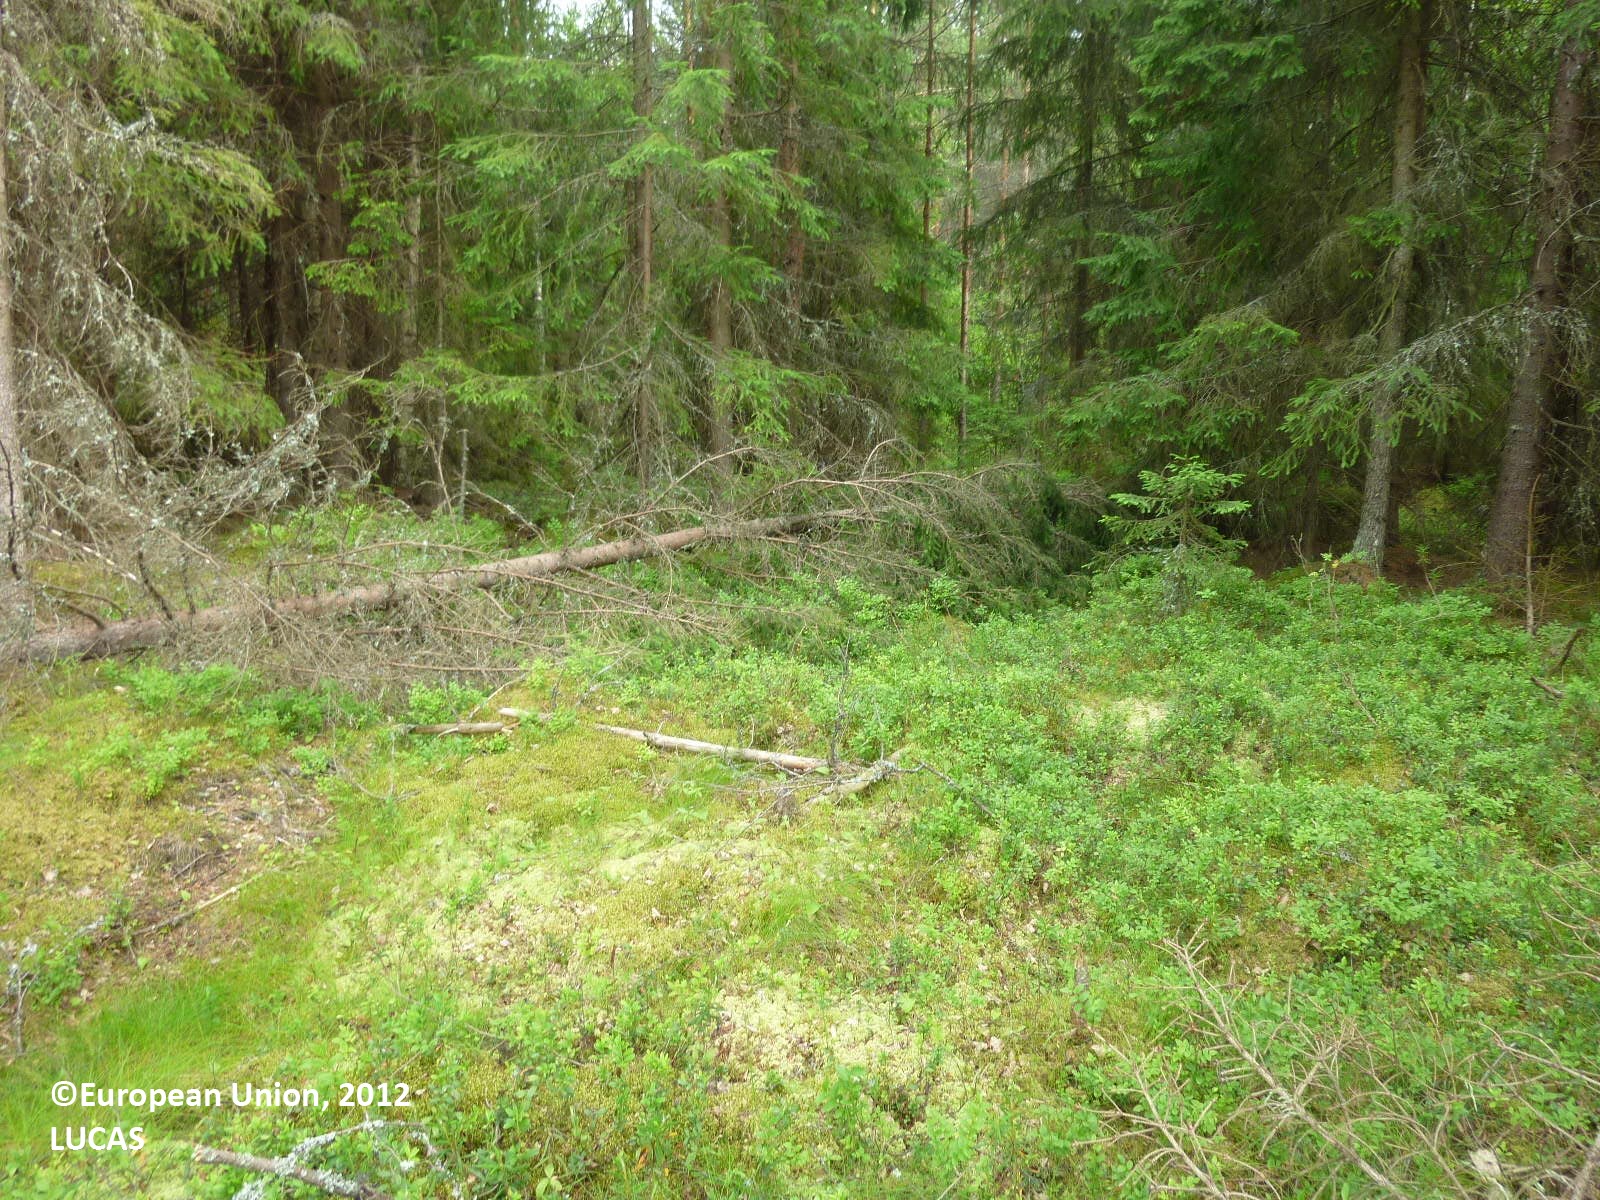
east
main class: Woodland
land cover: Spruce dominated mixed woodland
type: boreal forest
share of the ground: > 75 %
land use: Forestry
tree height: > 5 m
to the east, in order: Spruce dominated mixed woodland; Pine dominated coniferous woodland; Ditches and canals; Pine dominated coniferous woodland; Ditches and canals; Pine dominated coniferous woodland; Spruce dominated mixed woodland; Ditches and canals; Spruce dominated mixed woodland; Pine dominated coniferous woodland; Spruce dominated mixed woodland
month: July
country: FI
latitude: 61.1375
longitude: 22.7161
